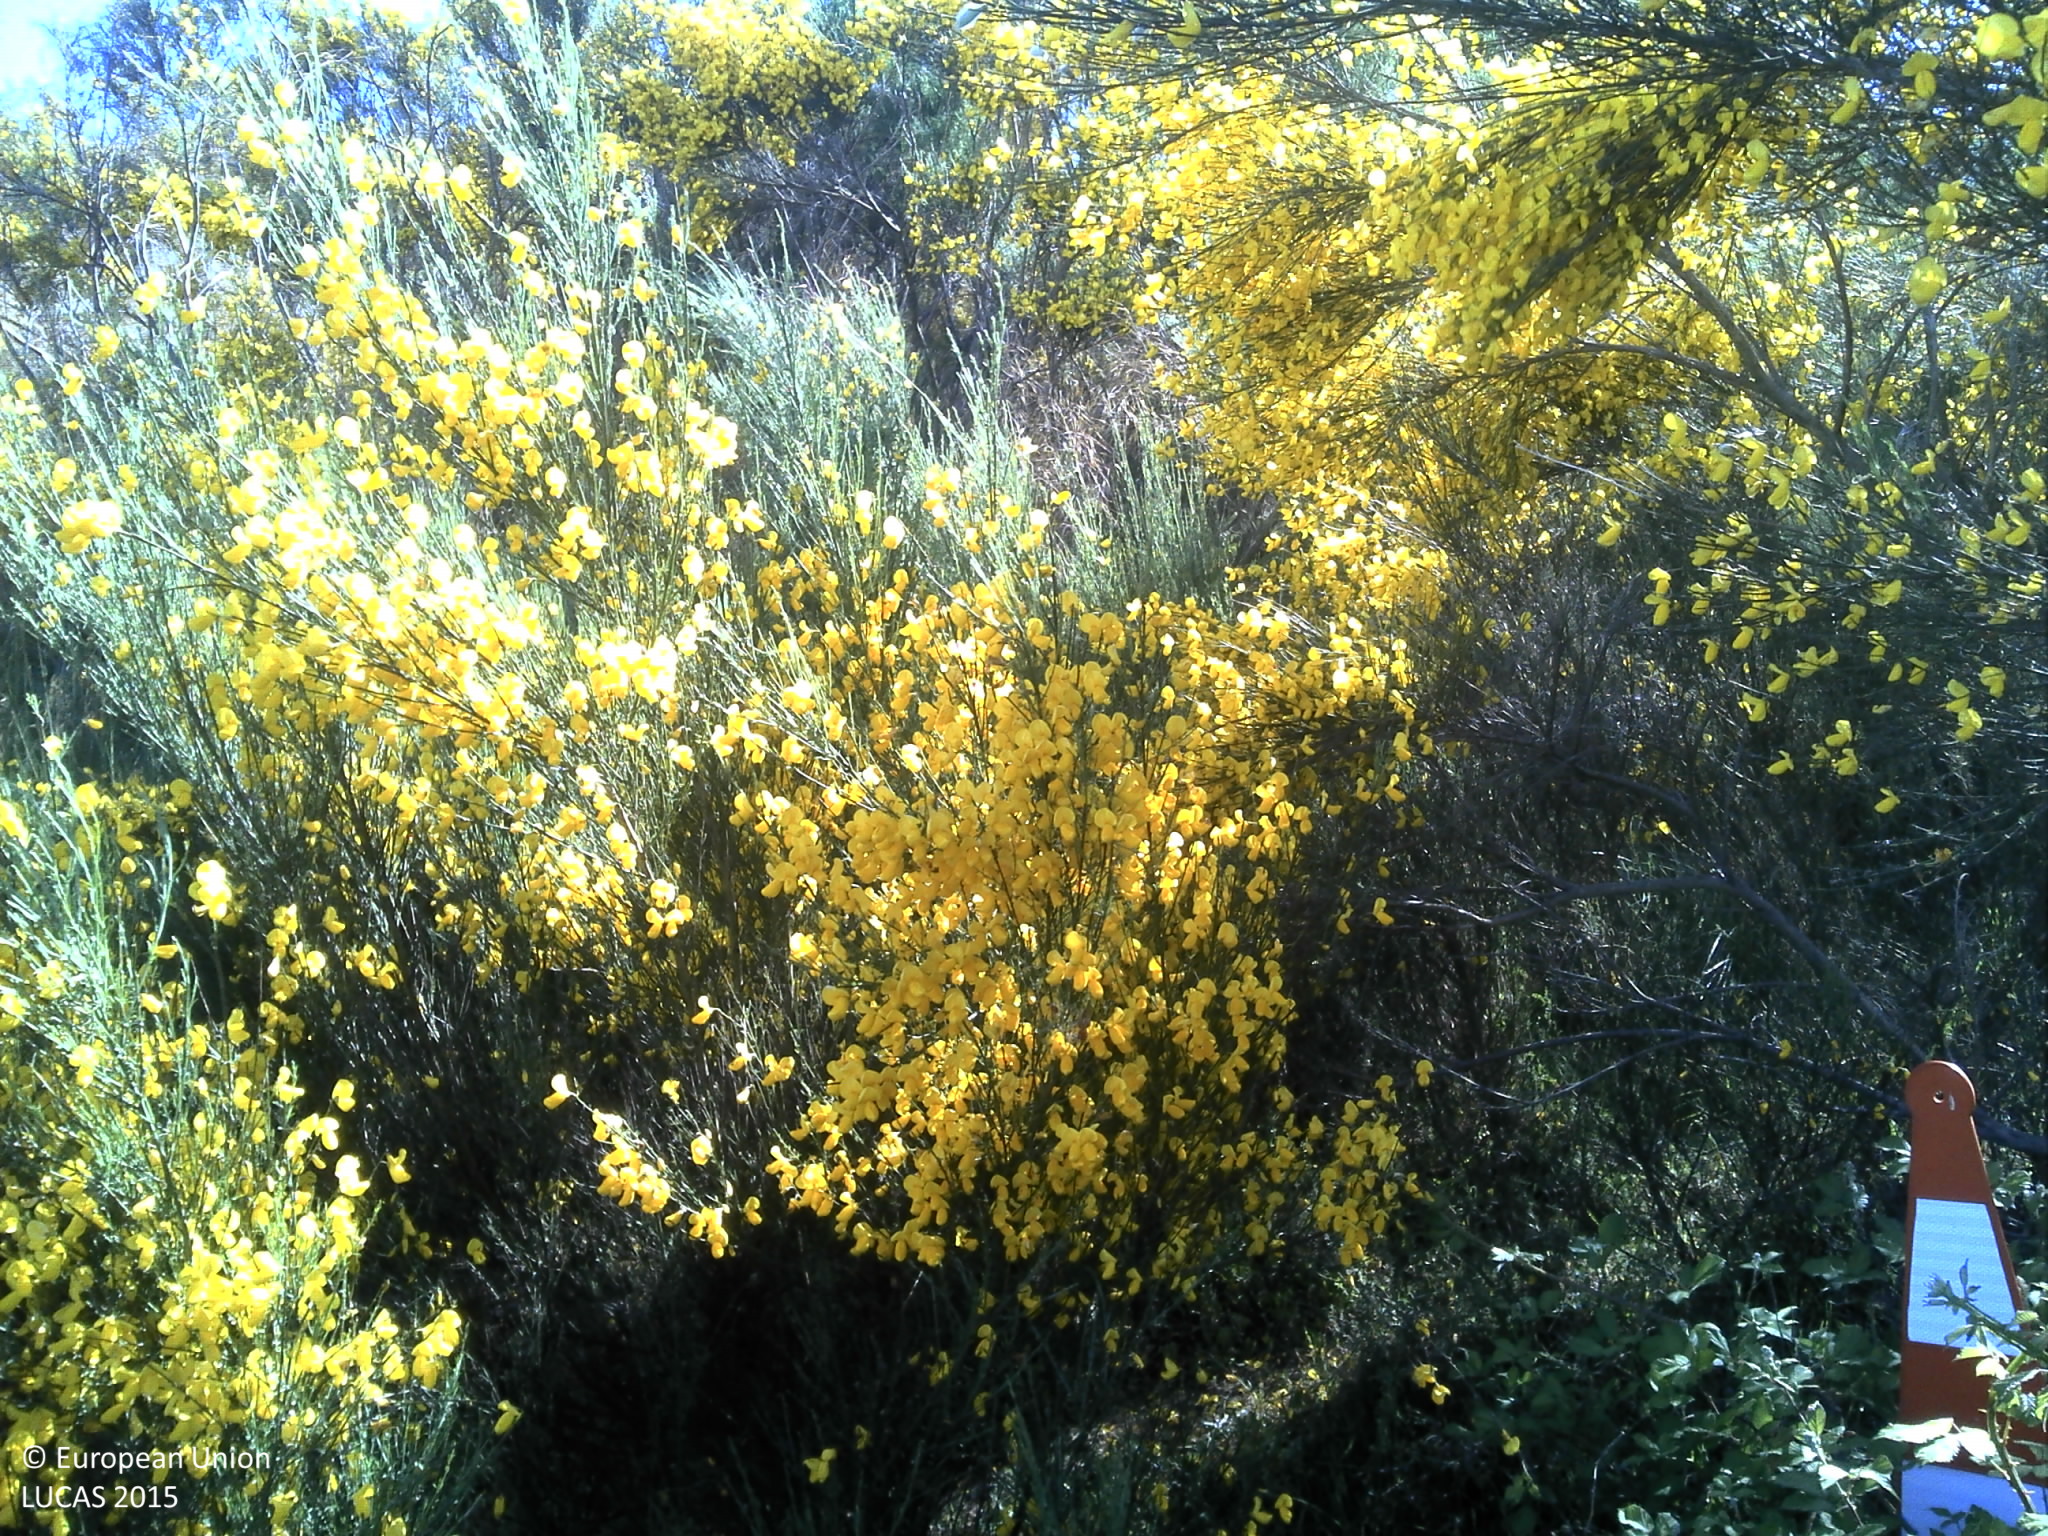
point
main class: Shrubland
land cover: Shrubland without tree cover
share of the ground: 50 - 75 %
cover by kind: shrubs 70 %, herbaceous plants 10 %, unconsolidated bare surface 10 %
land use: Semi-natural and natural areas not in use
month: May
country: PT
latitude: 40.5563
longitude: -7.4351
